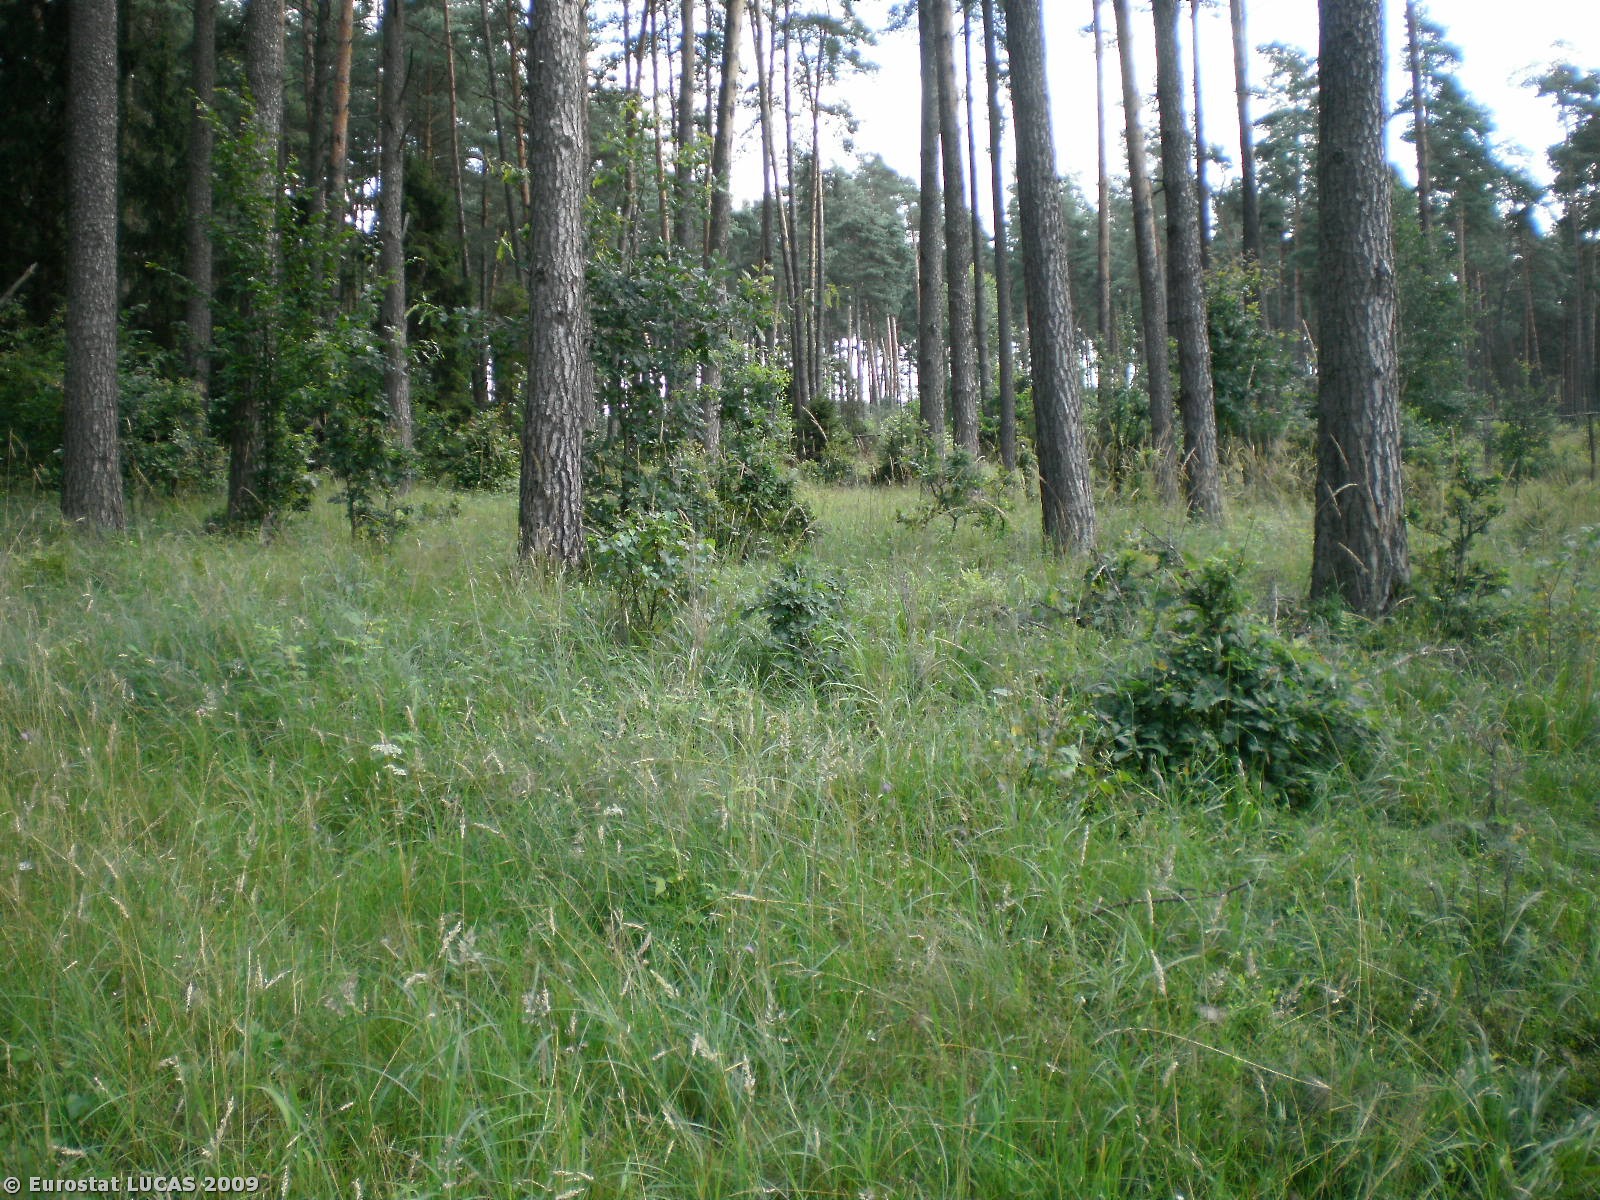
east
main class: Woodland
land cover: Coniferous woodland
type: hemiboreal forest and nemoral coniferous forest and mixed broadleaved-coniferous forest
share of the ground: 25 - 50 %
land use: Forestry
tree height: > 5 m
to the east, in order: Coniferous woodland
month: July
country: PL
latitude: 53.4543
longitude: 20.4730
